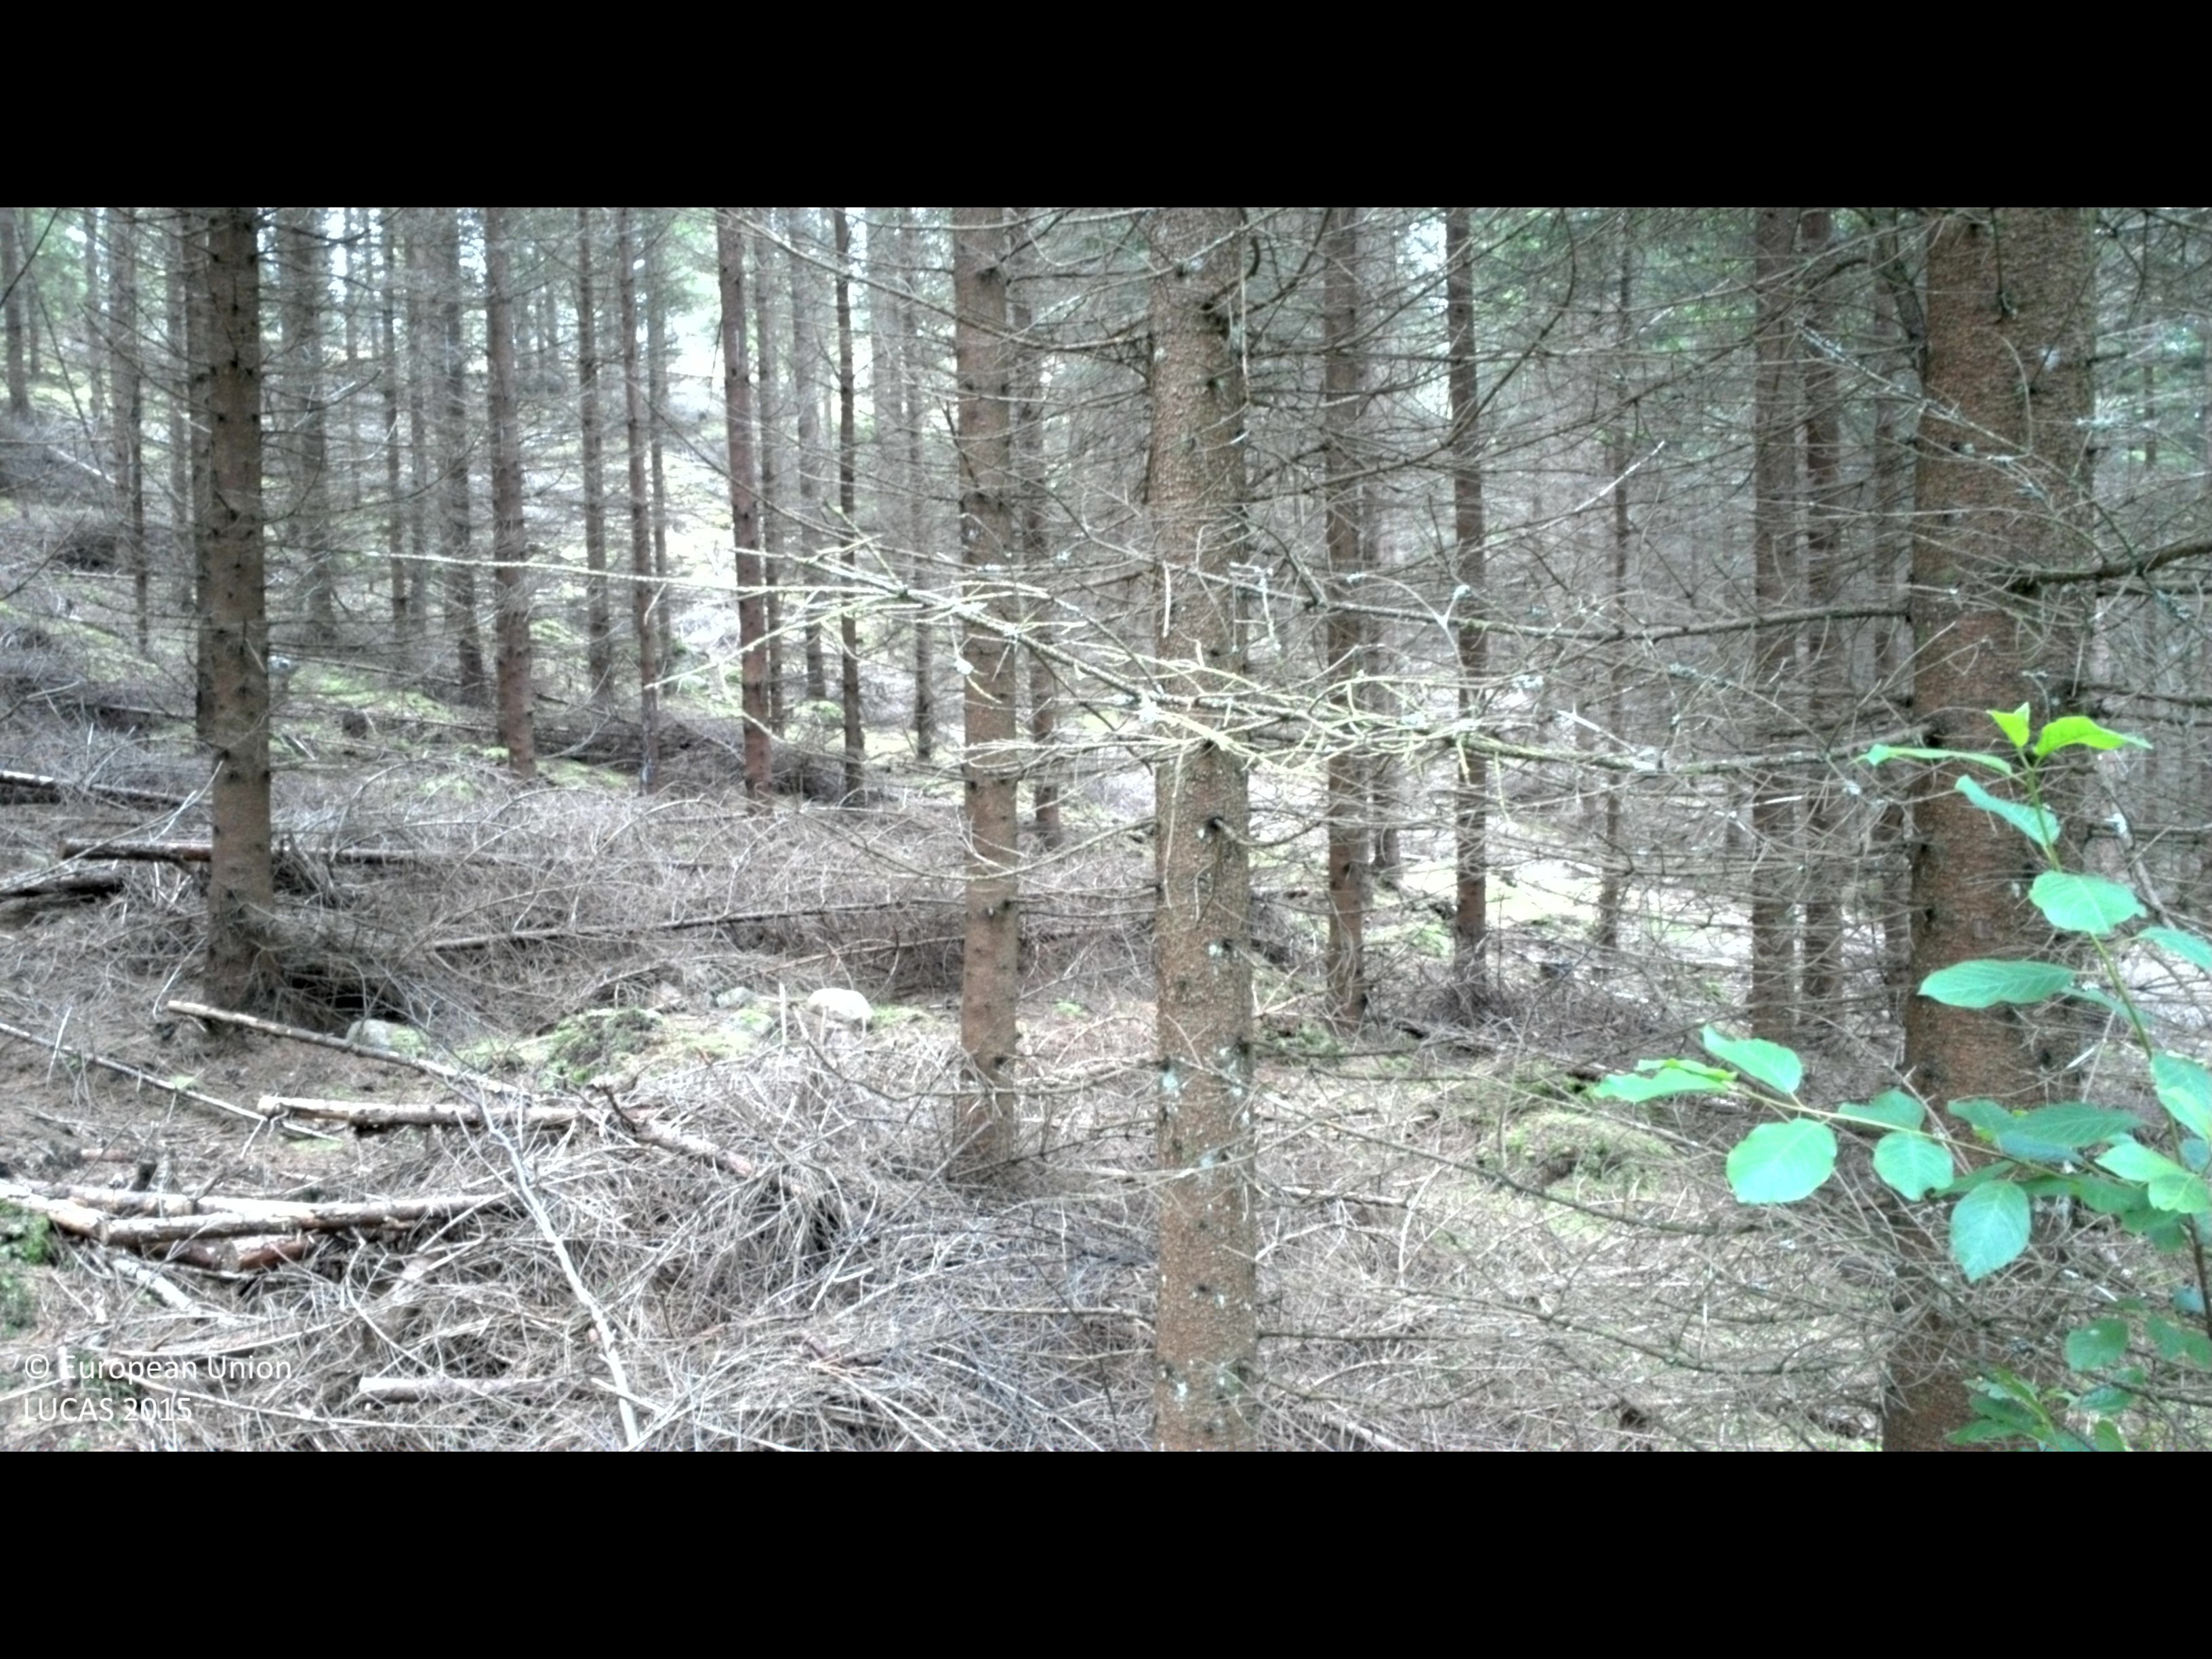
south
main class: Woodland
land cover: Spruce dominated coniferous woodland
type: boreal forest
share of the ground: > 75 %
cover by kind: coniferous forest trees 75 %, lichens and mosses 20 %
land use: Forestry
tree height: > 5 m
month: August
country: SE
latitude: 56.6527
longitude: 13.8299
